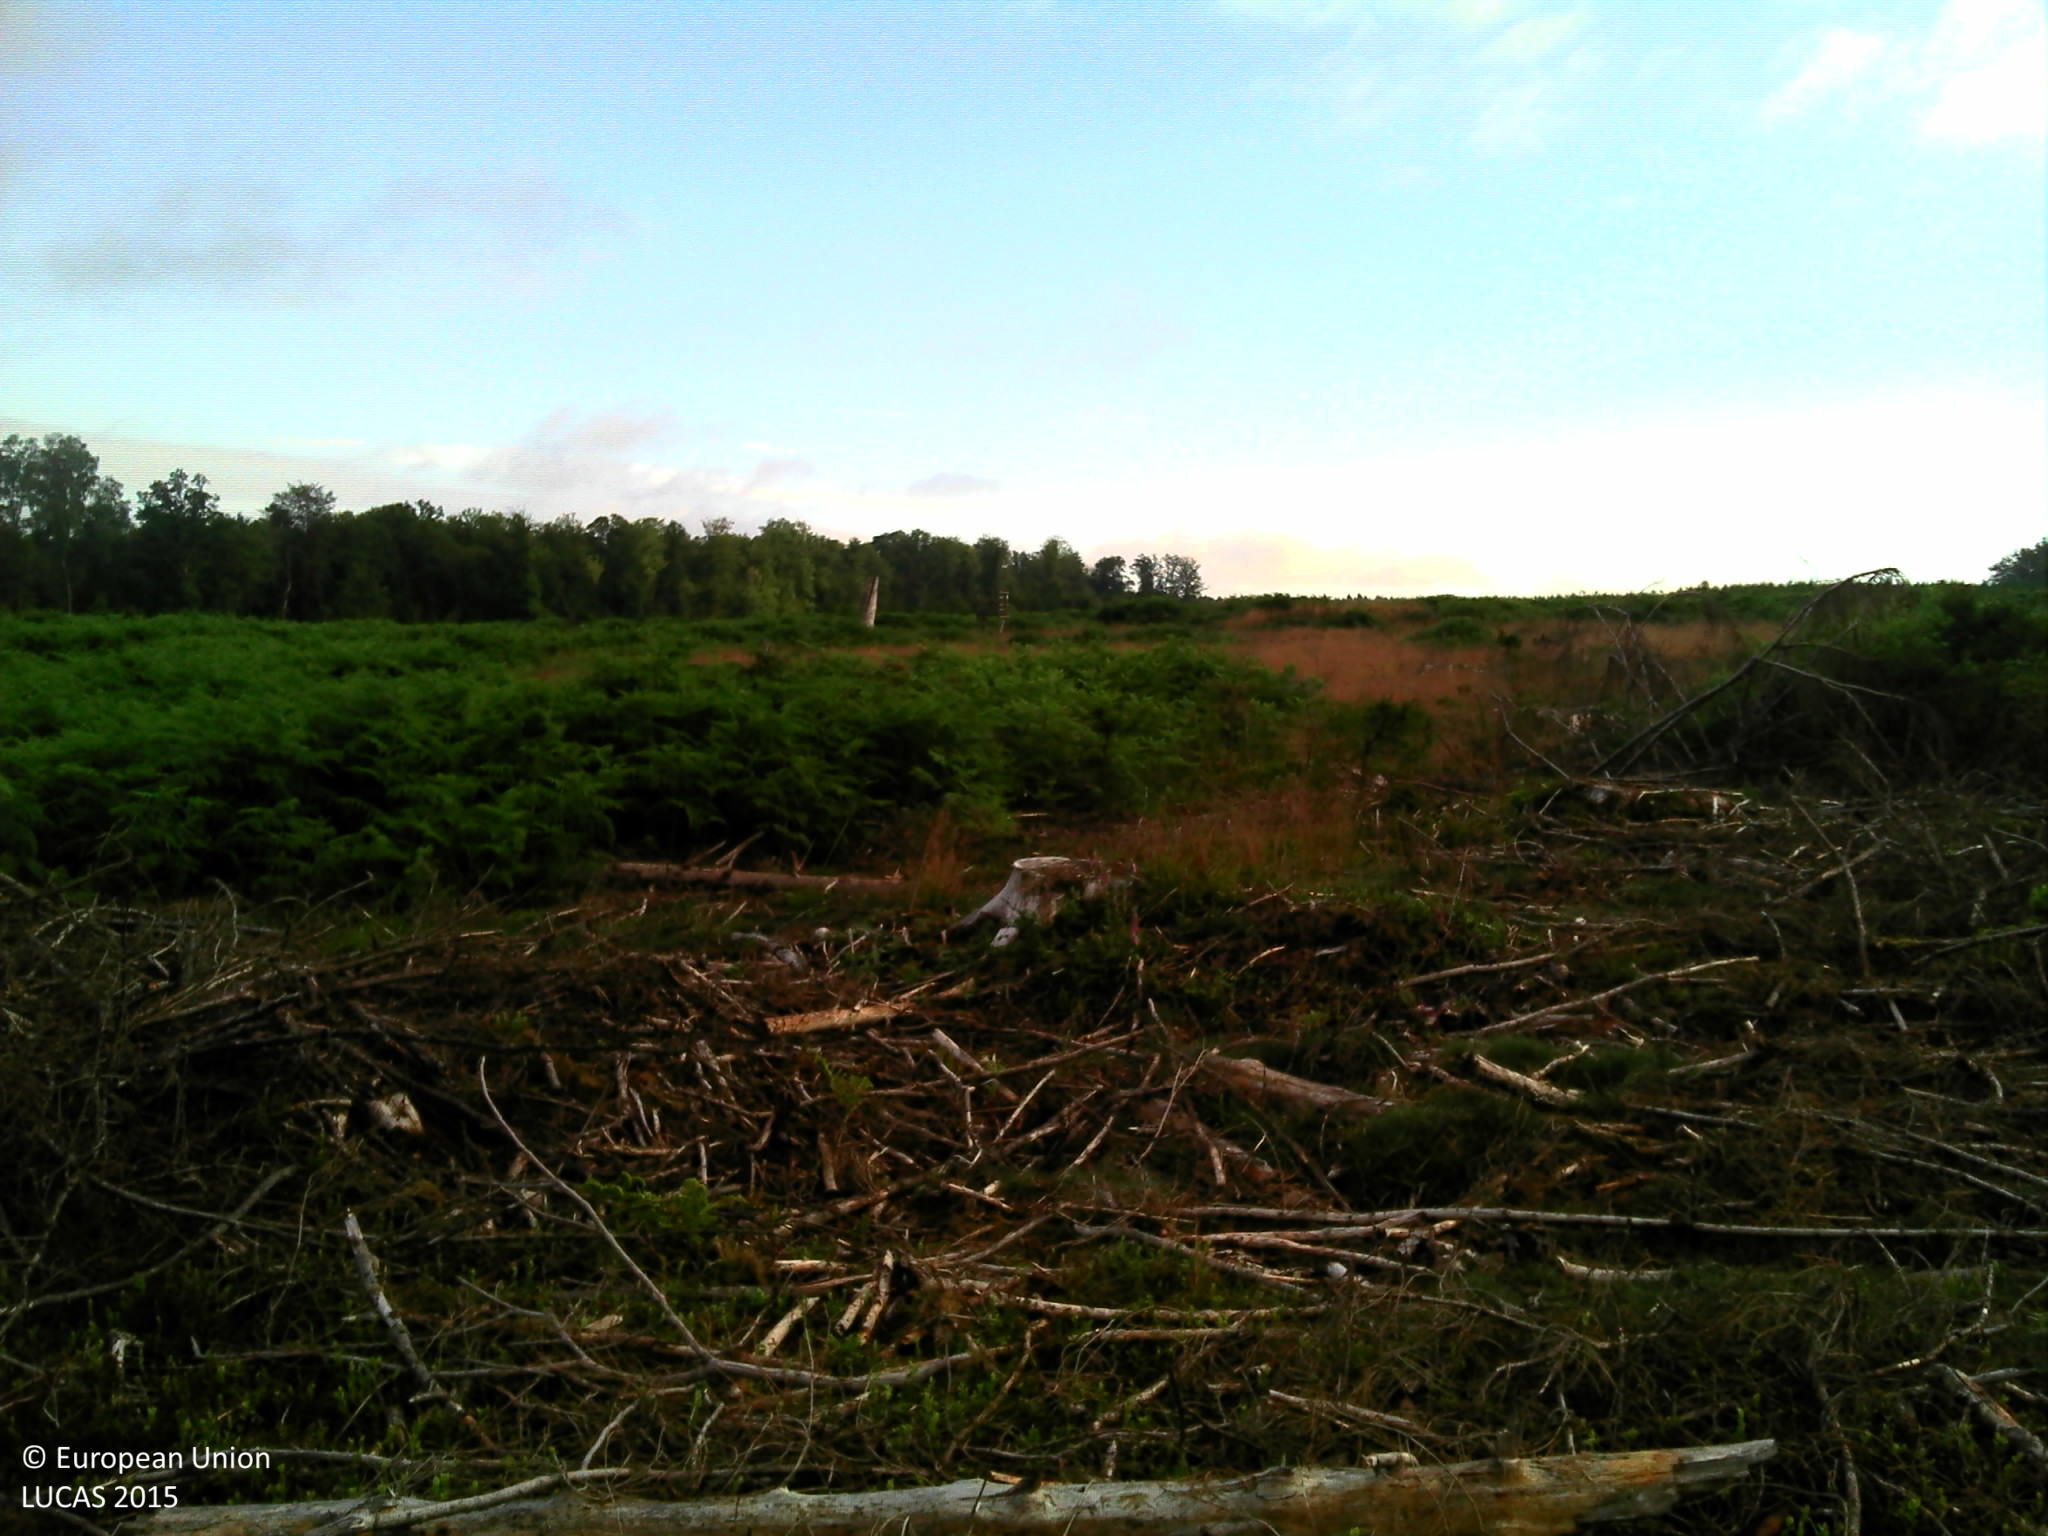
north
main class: Grassland
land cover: Spontaneously vegetated surfaces
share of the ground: 50 - 75 %
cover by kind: herbaceous plants 65 %, unconsolidated bare surface 30 %, shrubs 5 %
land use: Forestry
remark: Clear cut
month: July
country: BE
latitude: 49.7639
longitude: 5.3195
